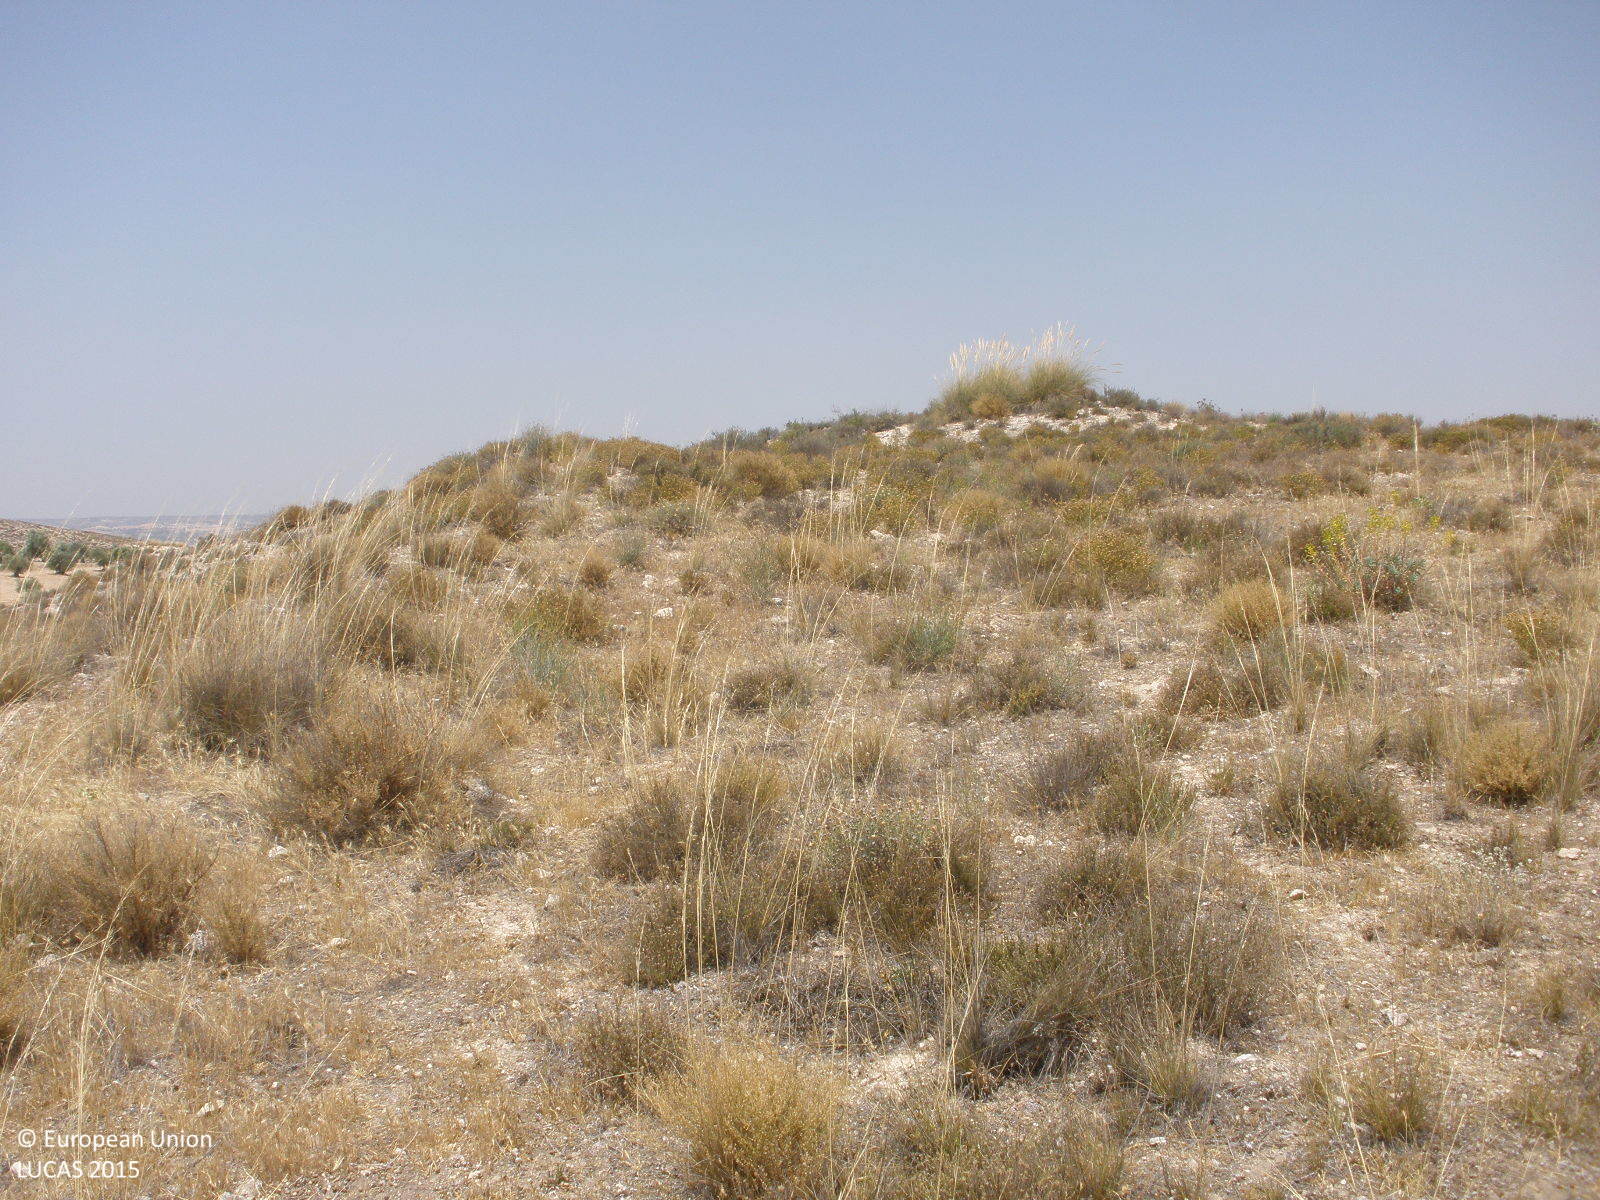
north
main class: Shrubland
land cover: Shrubland without tree cover
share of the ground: 25 - 50 %
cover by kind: herbaceous plants 70 %, shrubs 30 %
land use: Semi-natural and natural areas not in use
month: July
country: ES
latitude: 39.9964
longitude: -3.1789
